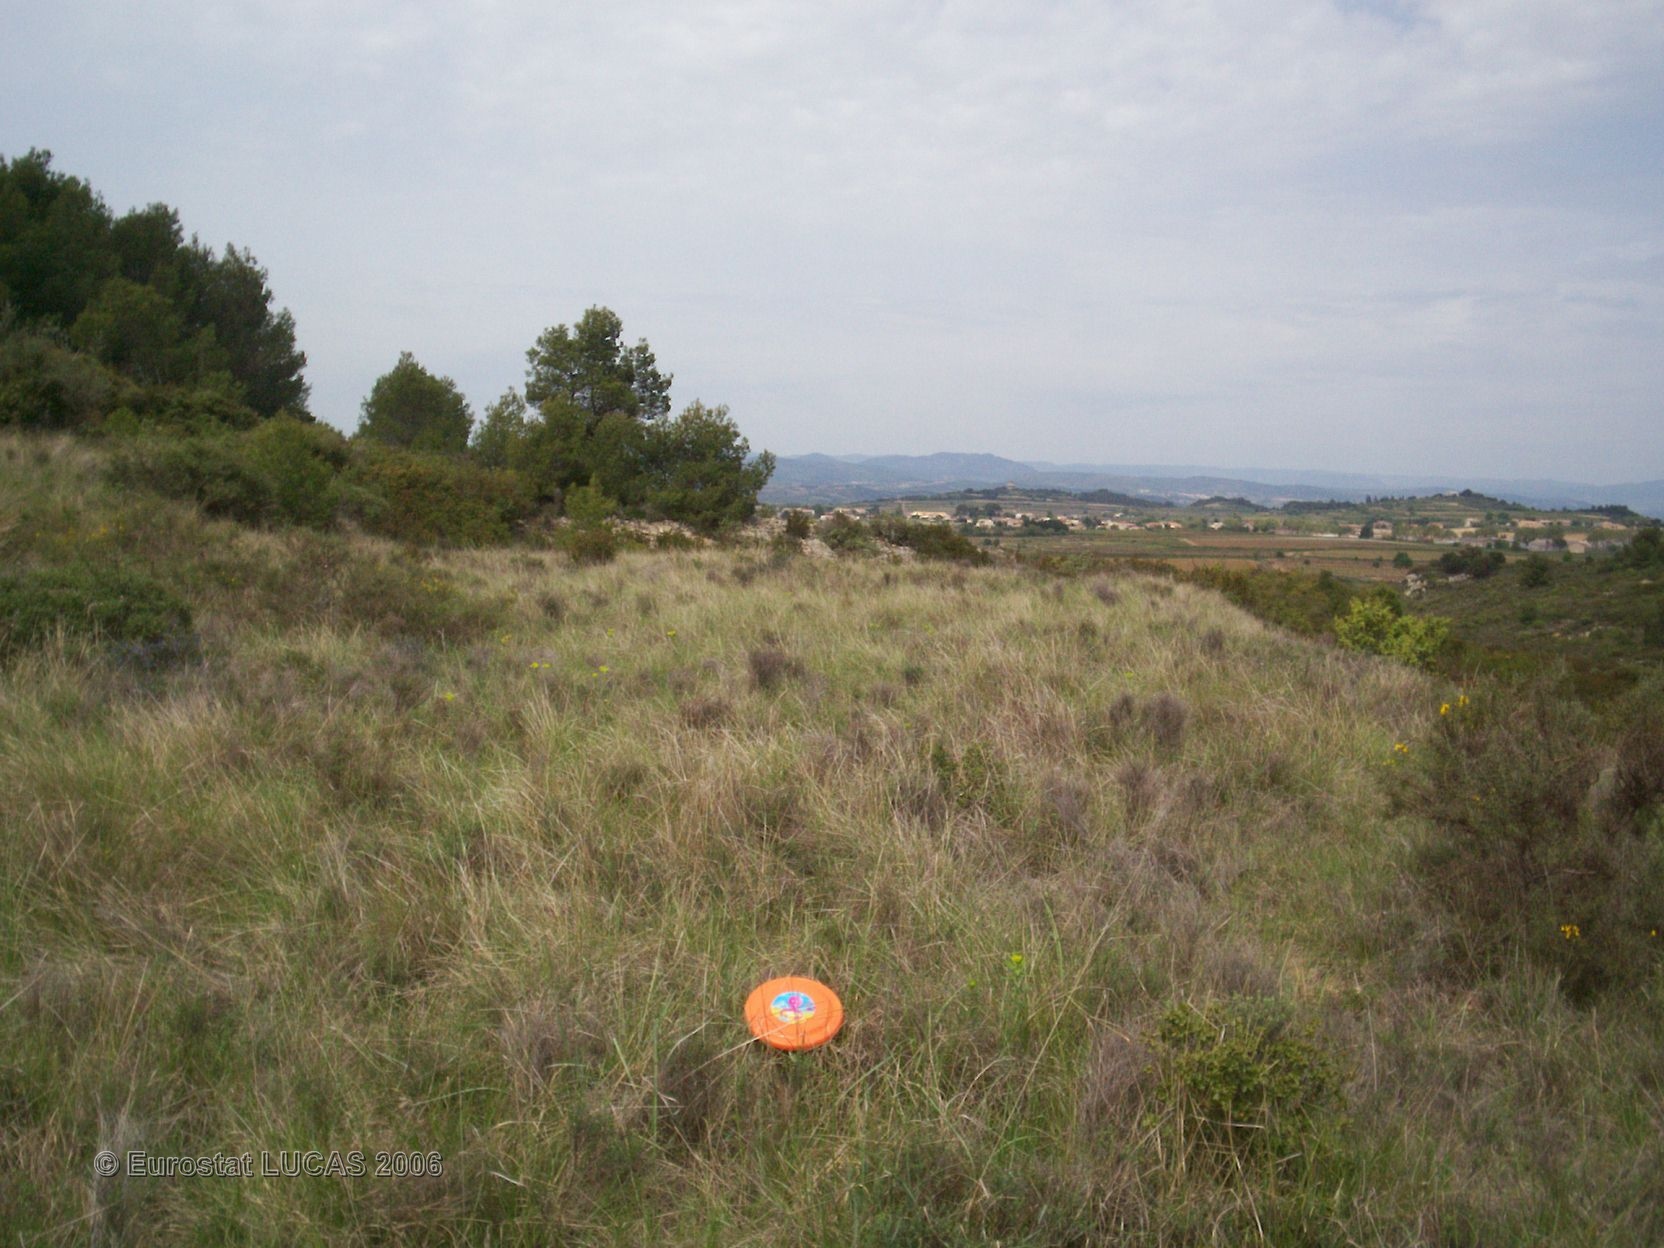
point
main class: Grassland
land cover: Grassland with sparse tree/shrub cover
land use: Unused
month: April
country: FR
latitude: 43.5159
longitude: 3.5393
